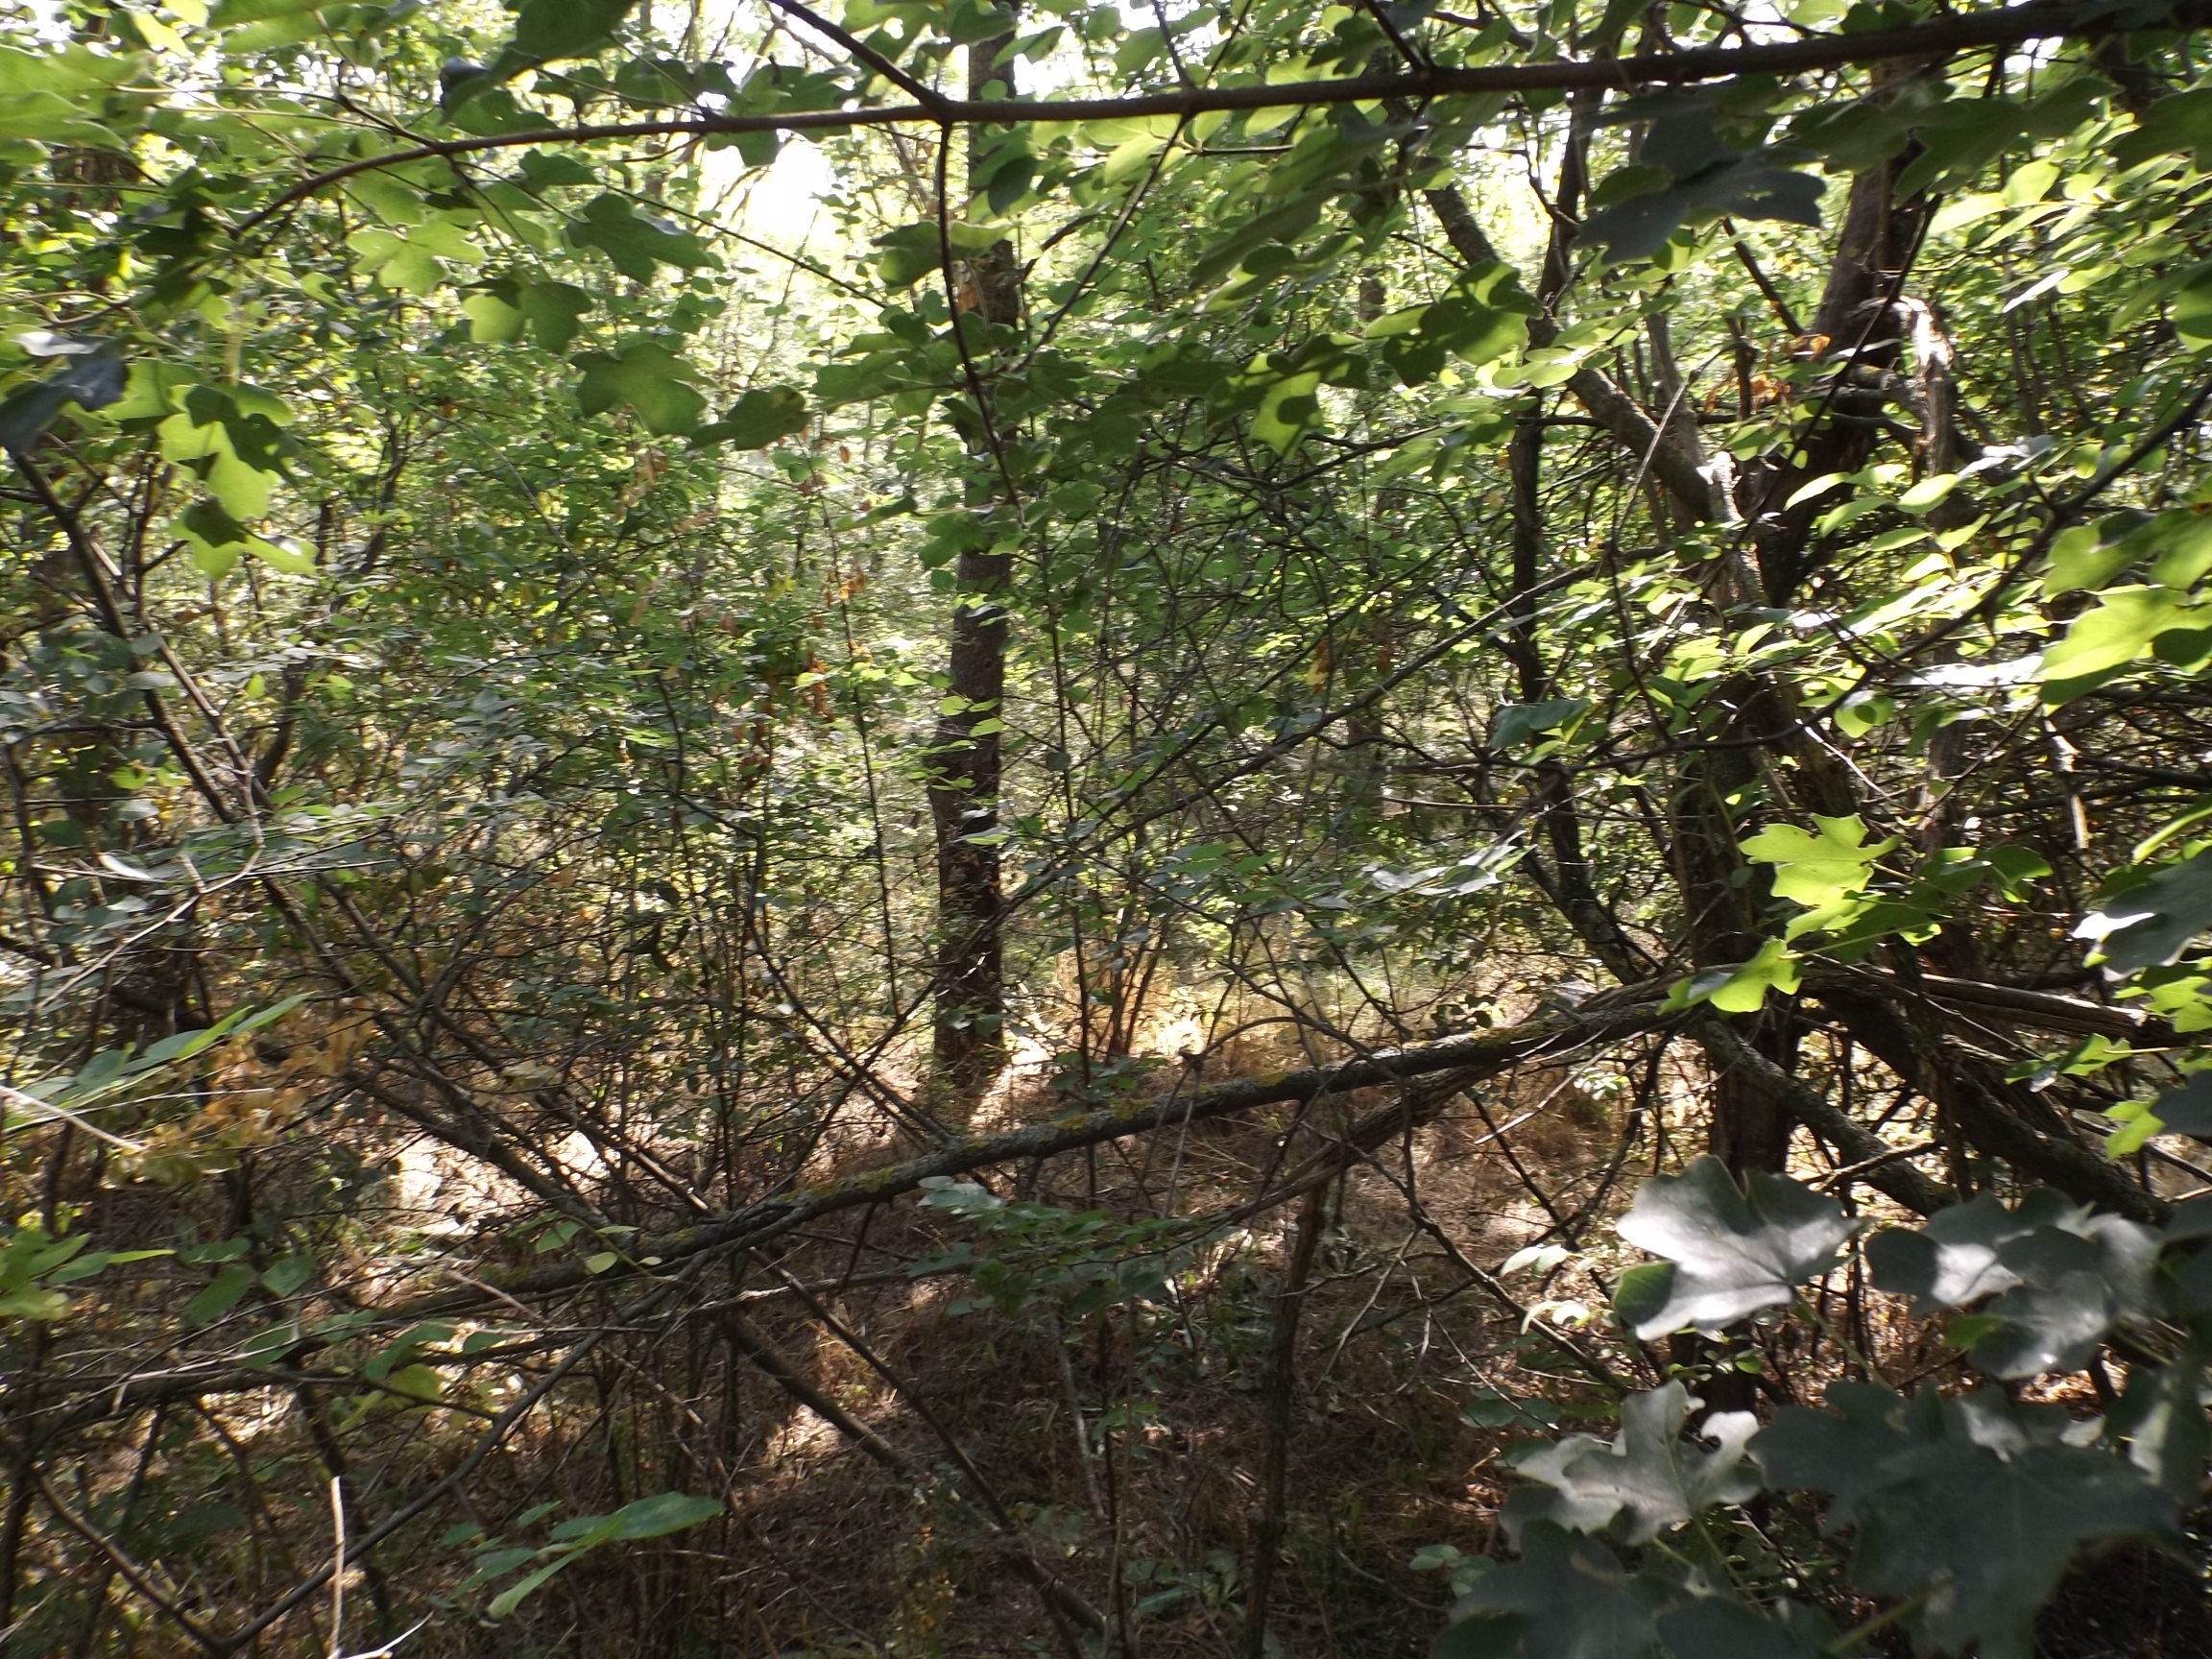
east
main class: Woodland
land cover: Broadleaved woodland
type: mesophytic deciduous forest
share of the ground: > 75 %
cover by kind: broadleaved forest trees 95 %, shrubs 5 %
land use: Forestry
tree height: > 5 m
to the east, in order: Broadleaved woodland; Fences; Broadleaved woodland; Paved roads, cycling and walking lanes
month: August
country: BG
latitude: 43.2370
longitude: 27.7058
